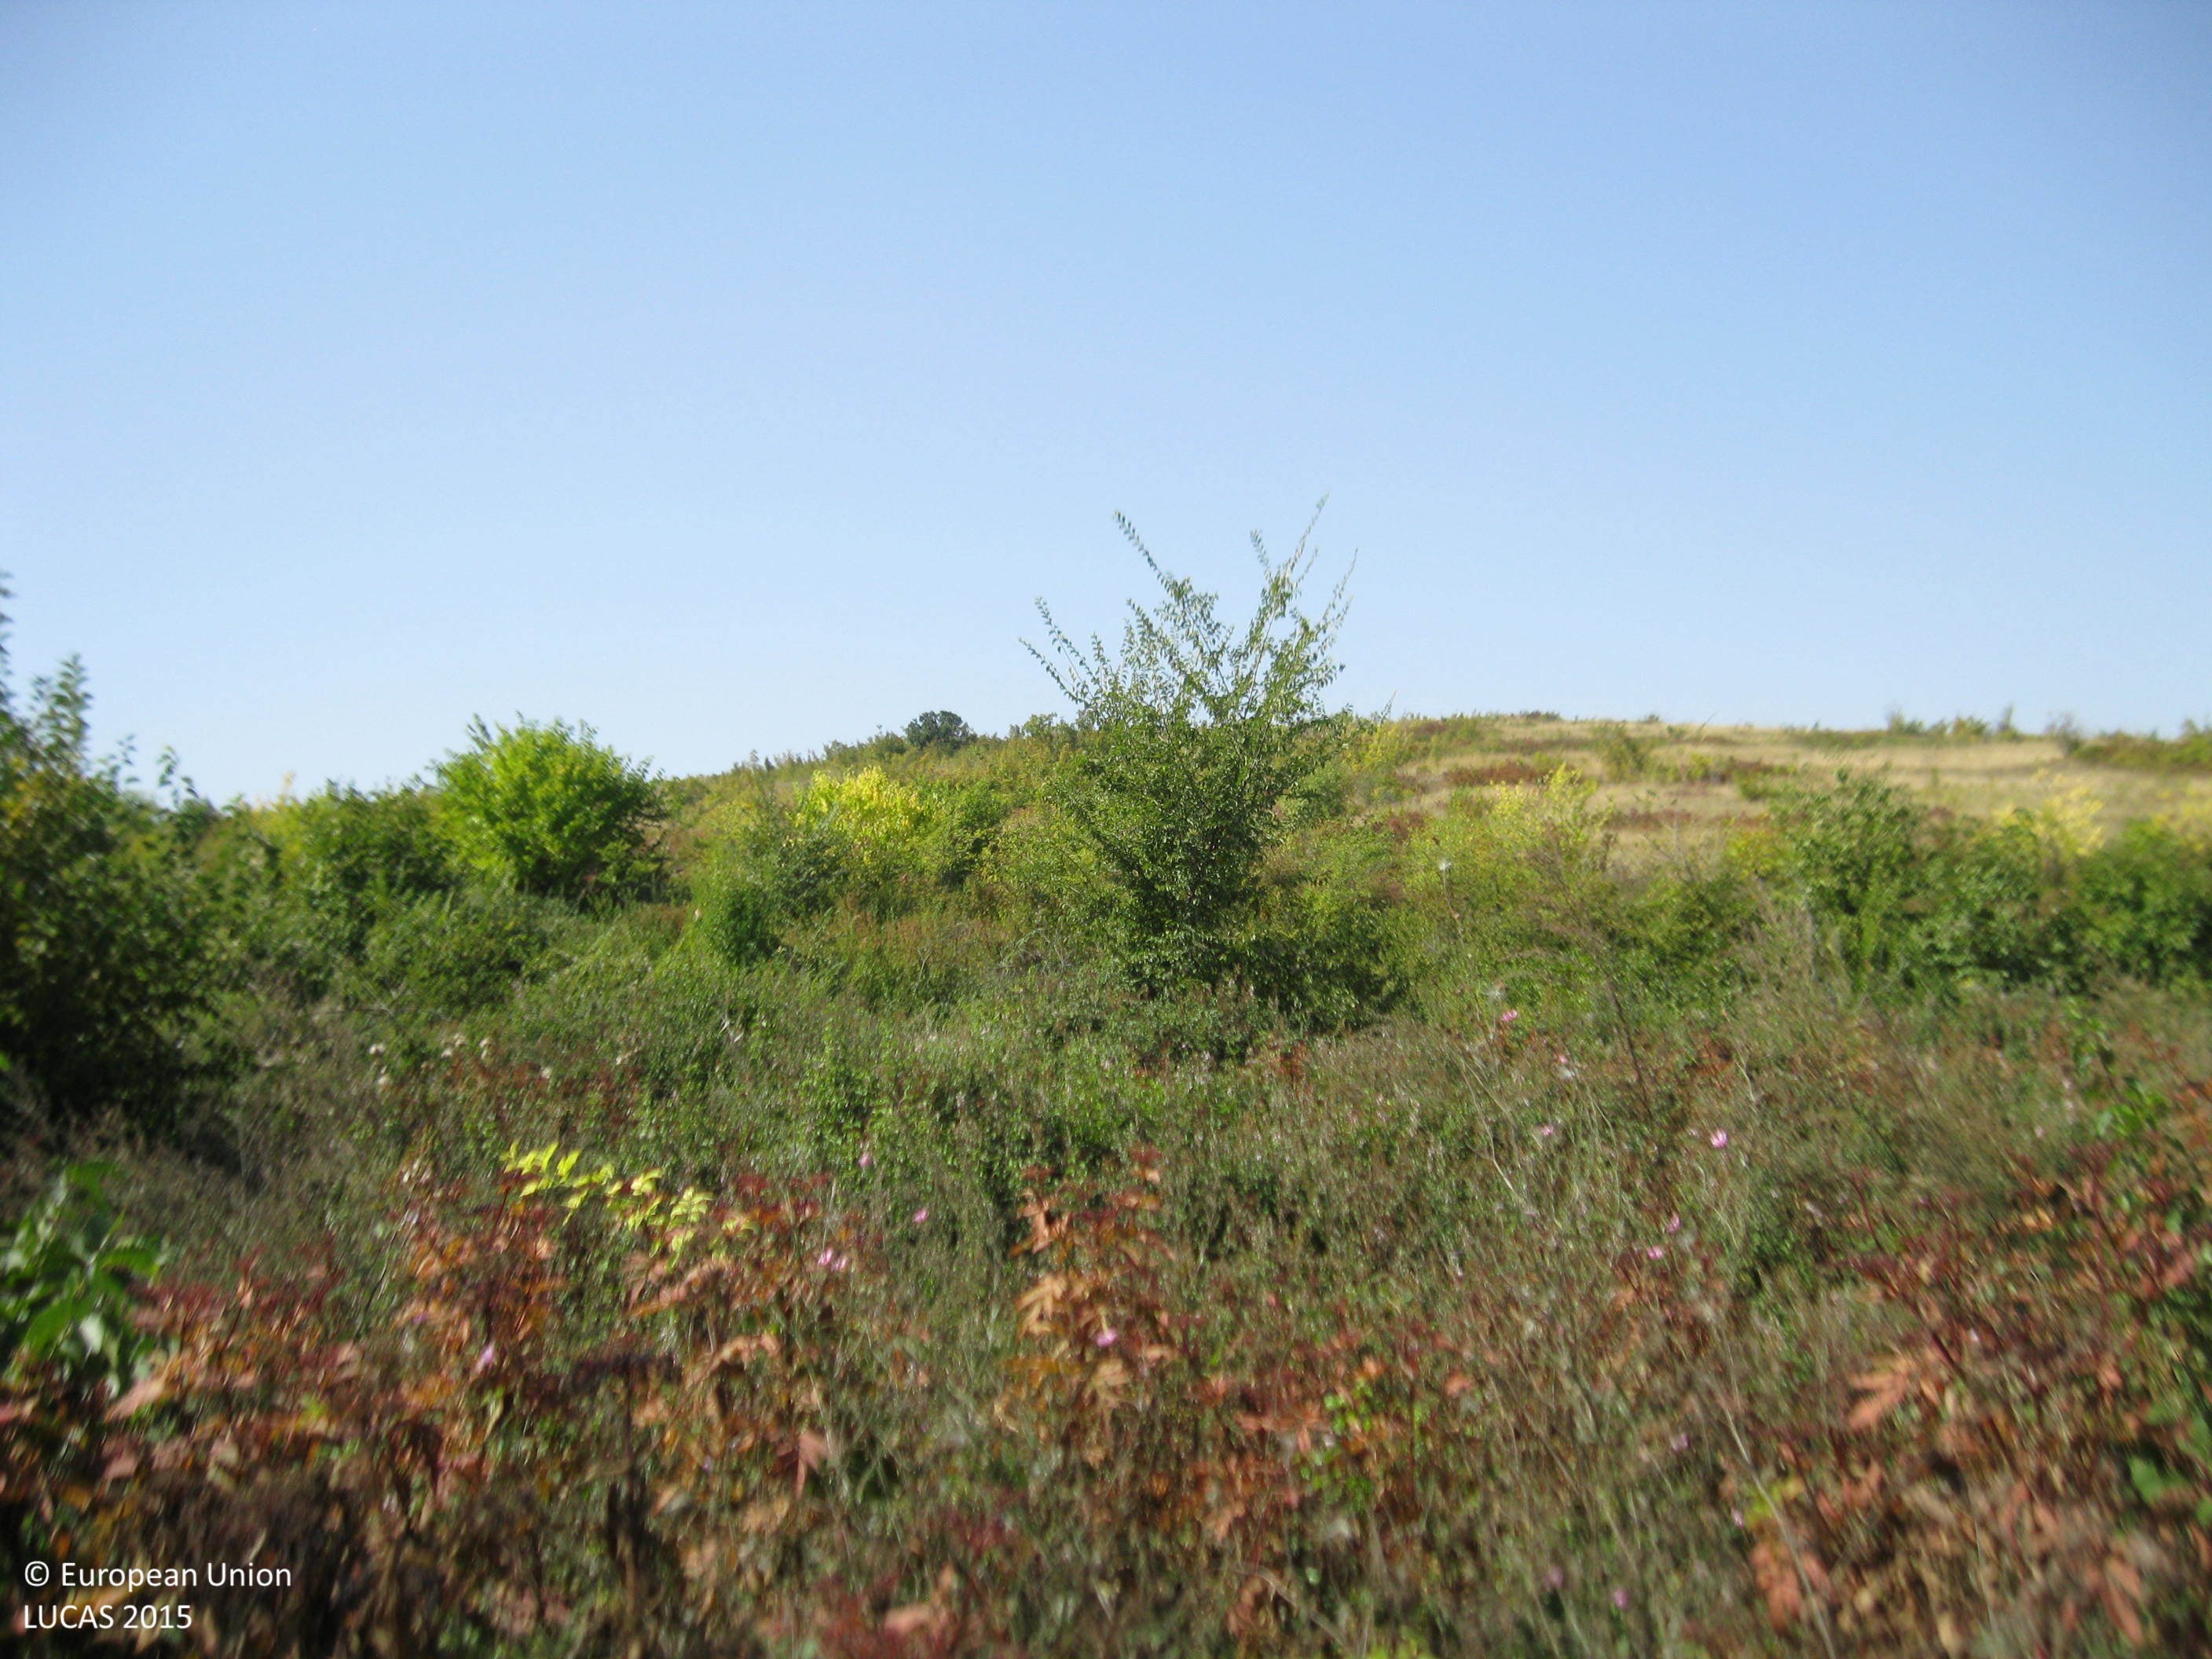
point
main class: Shrubland
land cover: Shrubland with sparse tree cover
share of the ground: > 75 %
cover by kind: herbaceous plants 60 %, shrubs 35 %, broadleaved forest trees 5 %
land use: Semi-natural and natural areas not in use
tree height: < 5 m
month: September
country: BG
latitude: 42.0749
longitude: 24.5392
